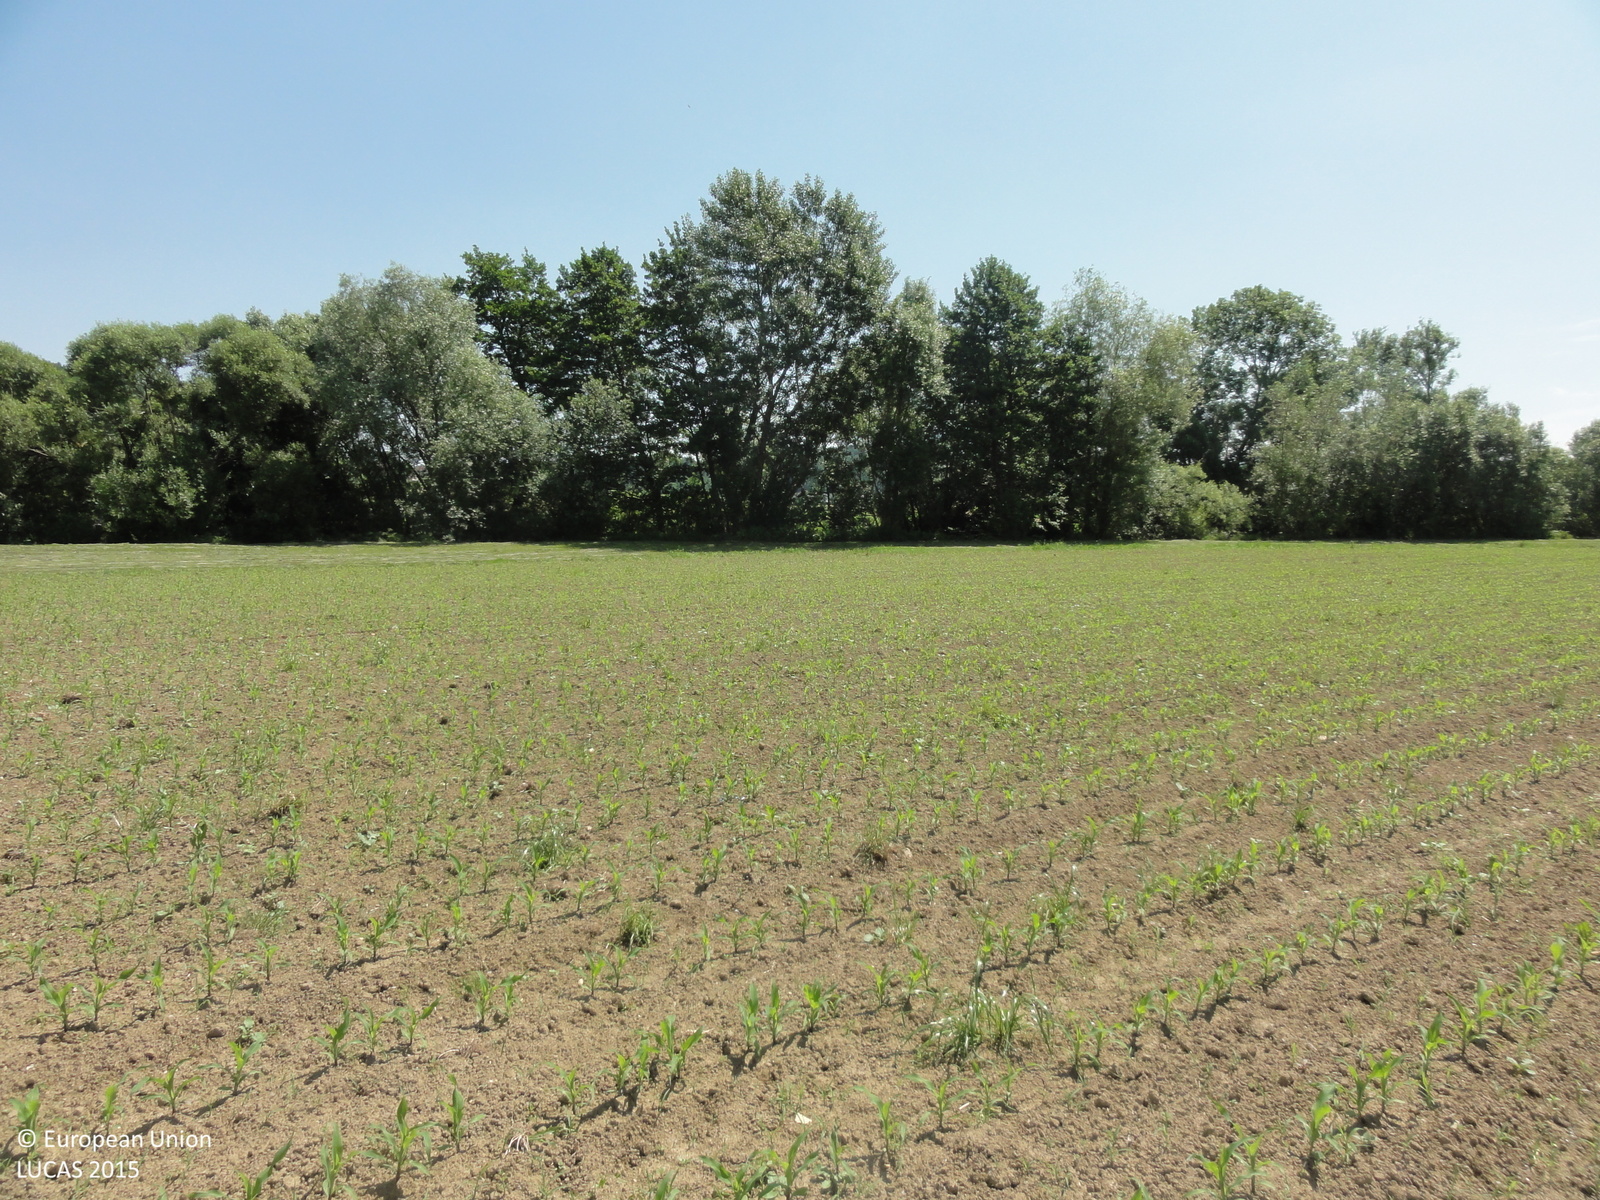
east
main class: Cropland
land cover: Maize
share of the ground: 10 - 25 %
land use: Agriculture (excluding fallow land and kitchen gardens)
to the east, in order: Maize; Grassland without tree/shrub cover; Broadleaved woodland; Inland fresh running water; Broadleaved woodland; Grassland without tree/shrub cover; Maize; Grassland without tree/shrub cover; Ditches and canals; Grassland without tree/shrub cover
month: June
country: SI
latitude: 46.3184
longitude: 15.4918
